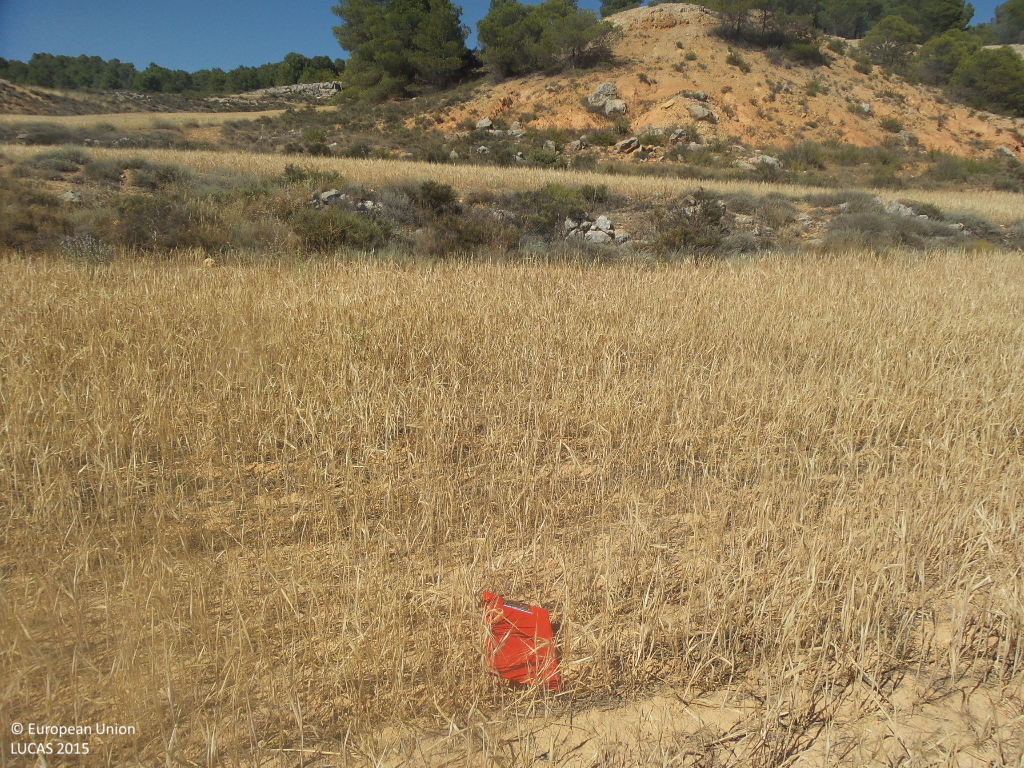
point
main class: Cropland
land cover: Barley
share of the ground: > 75 %
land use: Agriculture (excluding fallow land and kitchen gardens)
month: July
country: ES
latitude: 41.3255
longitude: -2.0842
